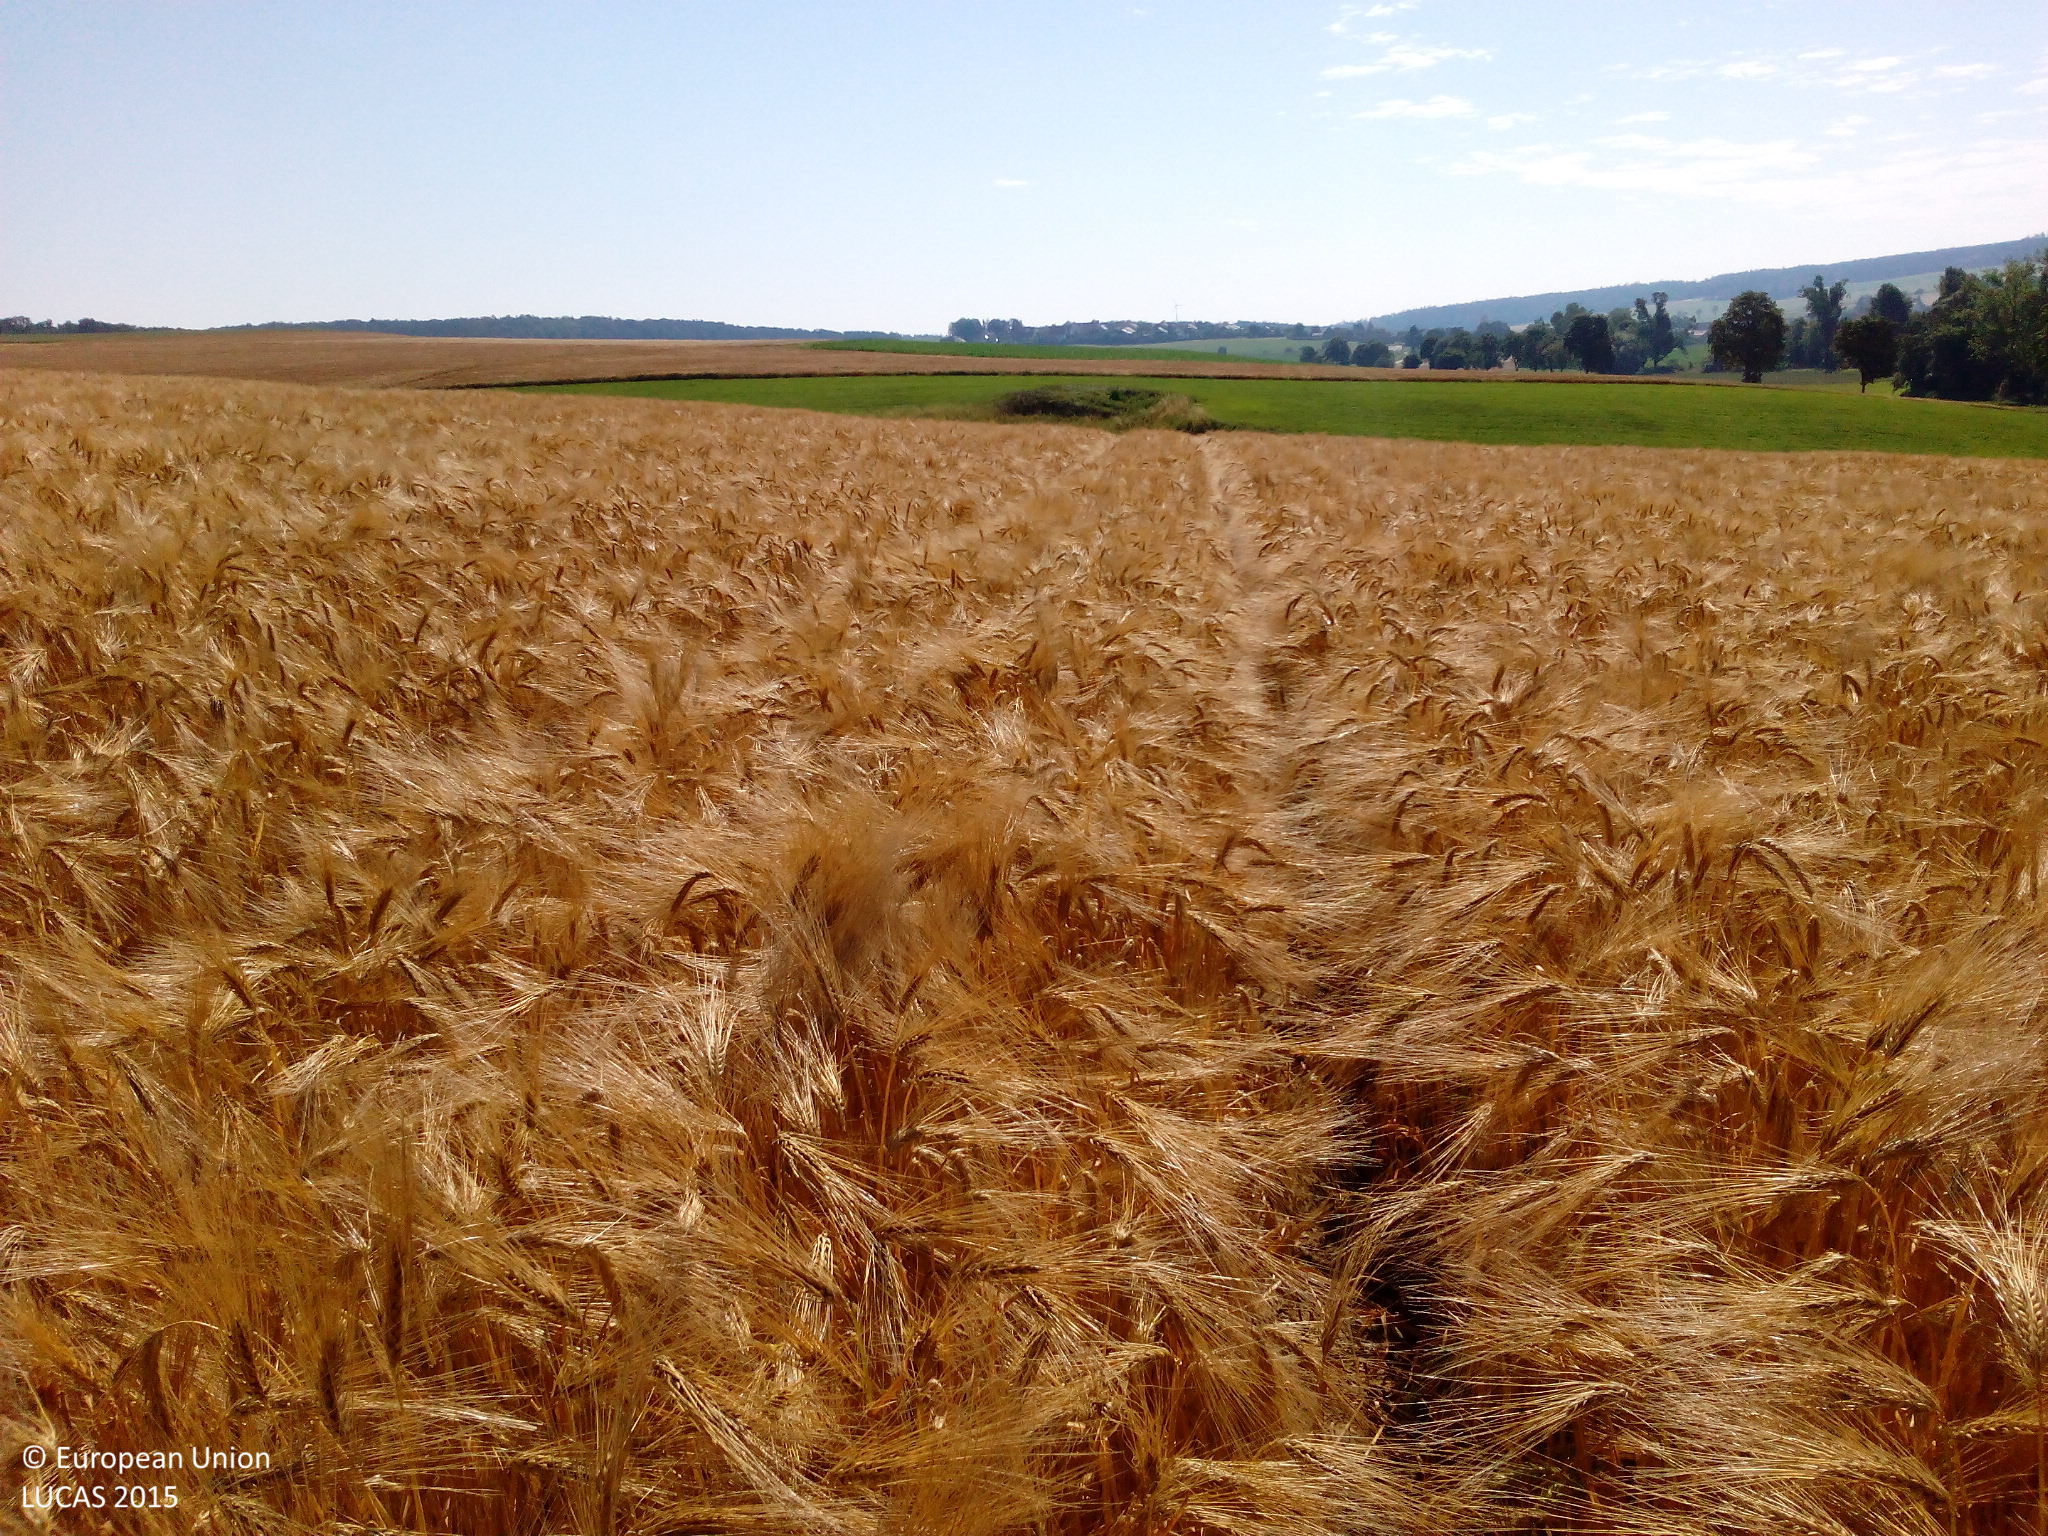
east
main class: Cropland
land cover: Barley
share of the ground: > 75 %
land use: Agriculture (excluding fallow land and kitchen gardens)
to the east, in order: Barley; Grass margins; Tracks; Grass margins; Ditches and canals; Grassland without tree/shrub cover; Electric lines; Grassland without tree/shrub cover; Common wheat
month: July
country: DE
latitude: 48.7958
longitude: 10.8844
